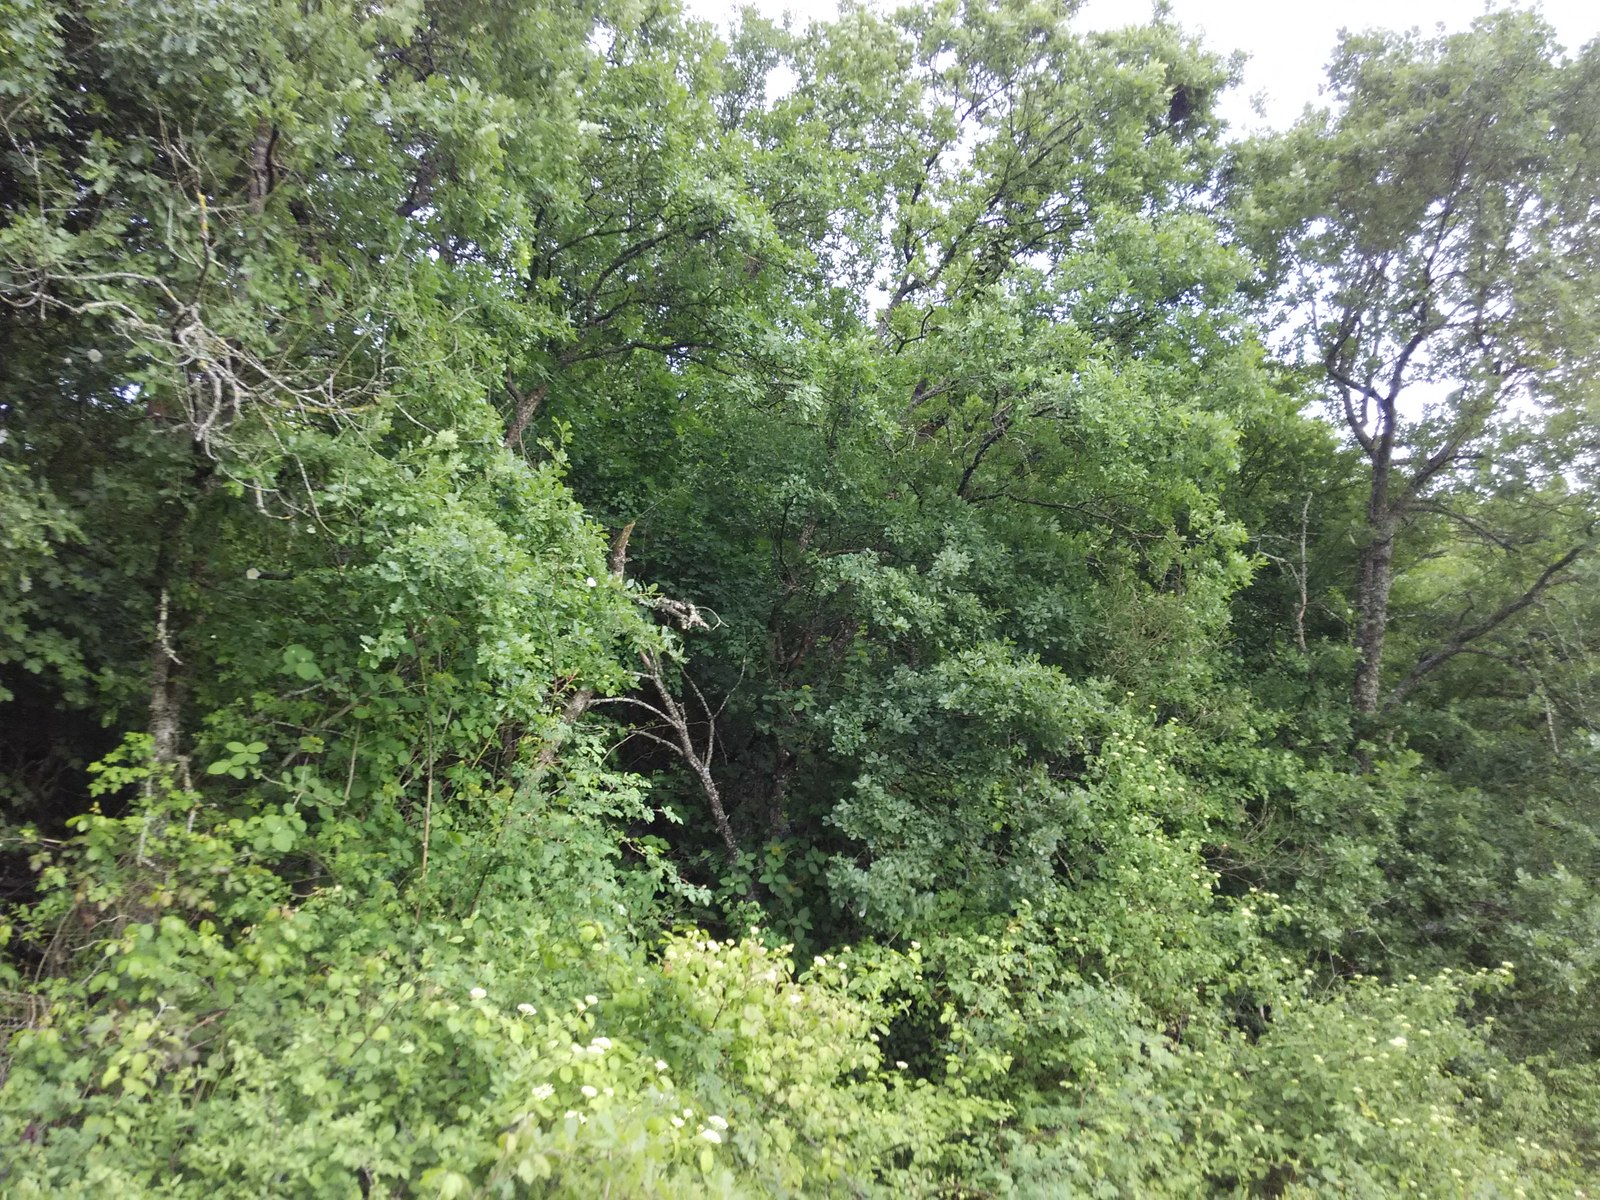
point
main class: Woodland
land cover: Broadleaved woodland
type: beech forest
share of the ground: 50 - 75 %
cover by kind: broadleaved forest trees 55 %, shrubs 30 %, herbaceous plants 15 %
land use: Forestry
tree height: > 5 m
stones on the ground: < 10 %
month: May
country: ES
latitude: 42.8445
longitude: -2.3443
